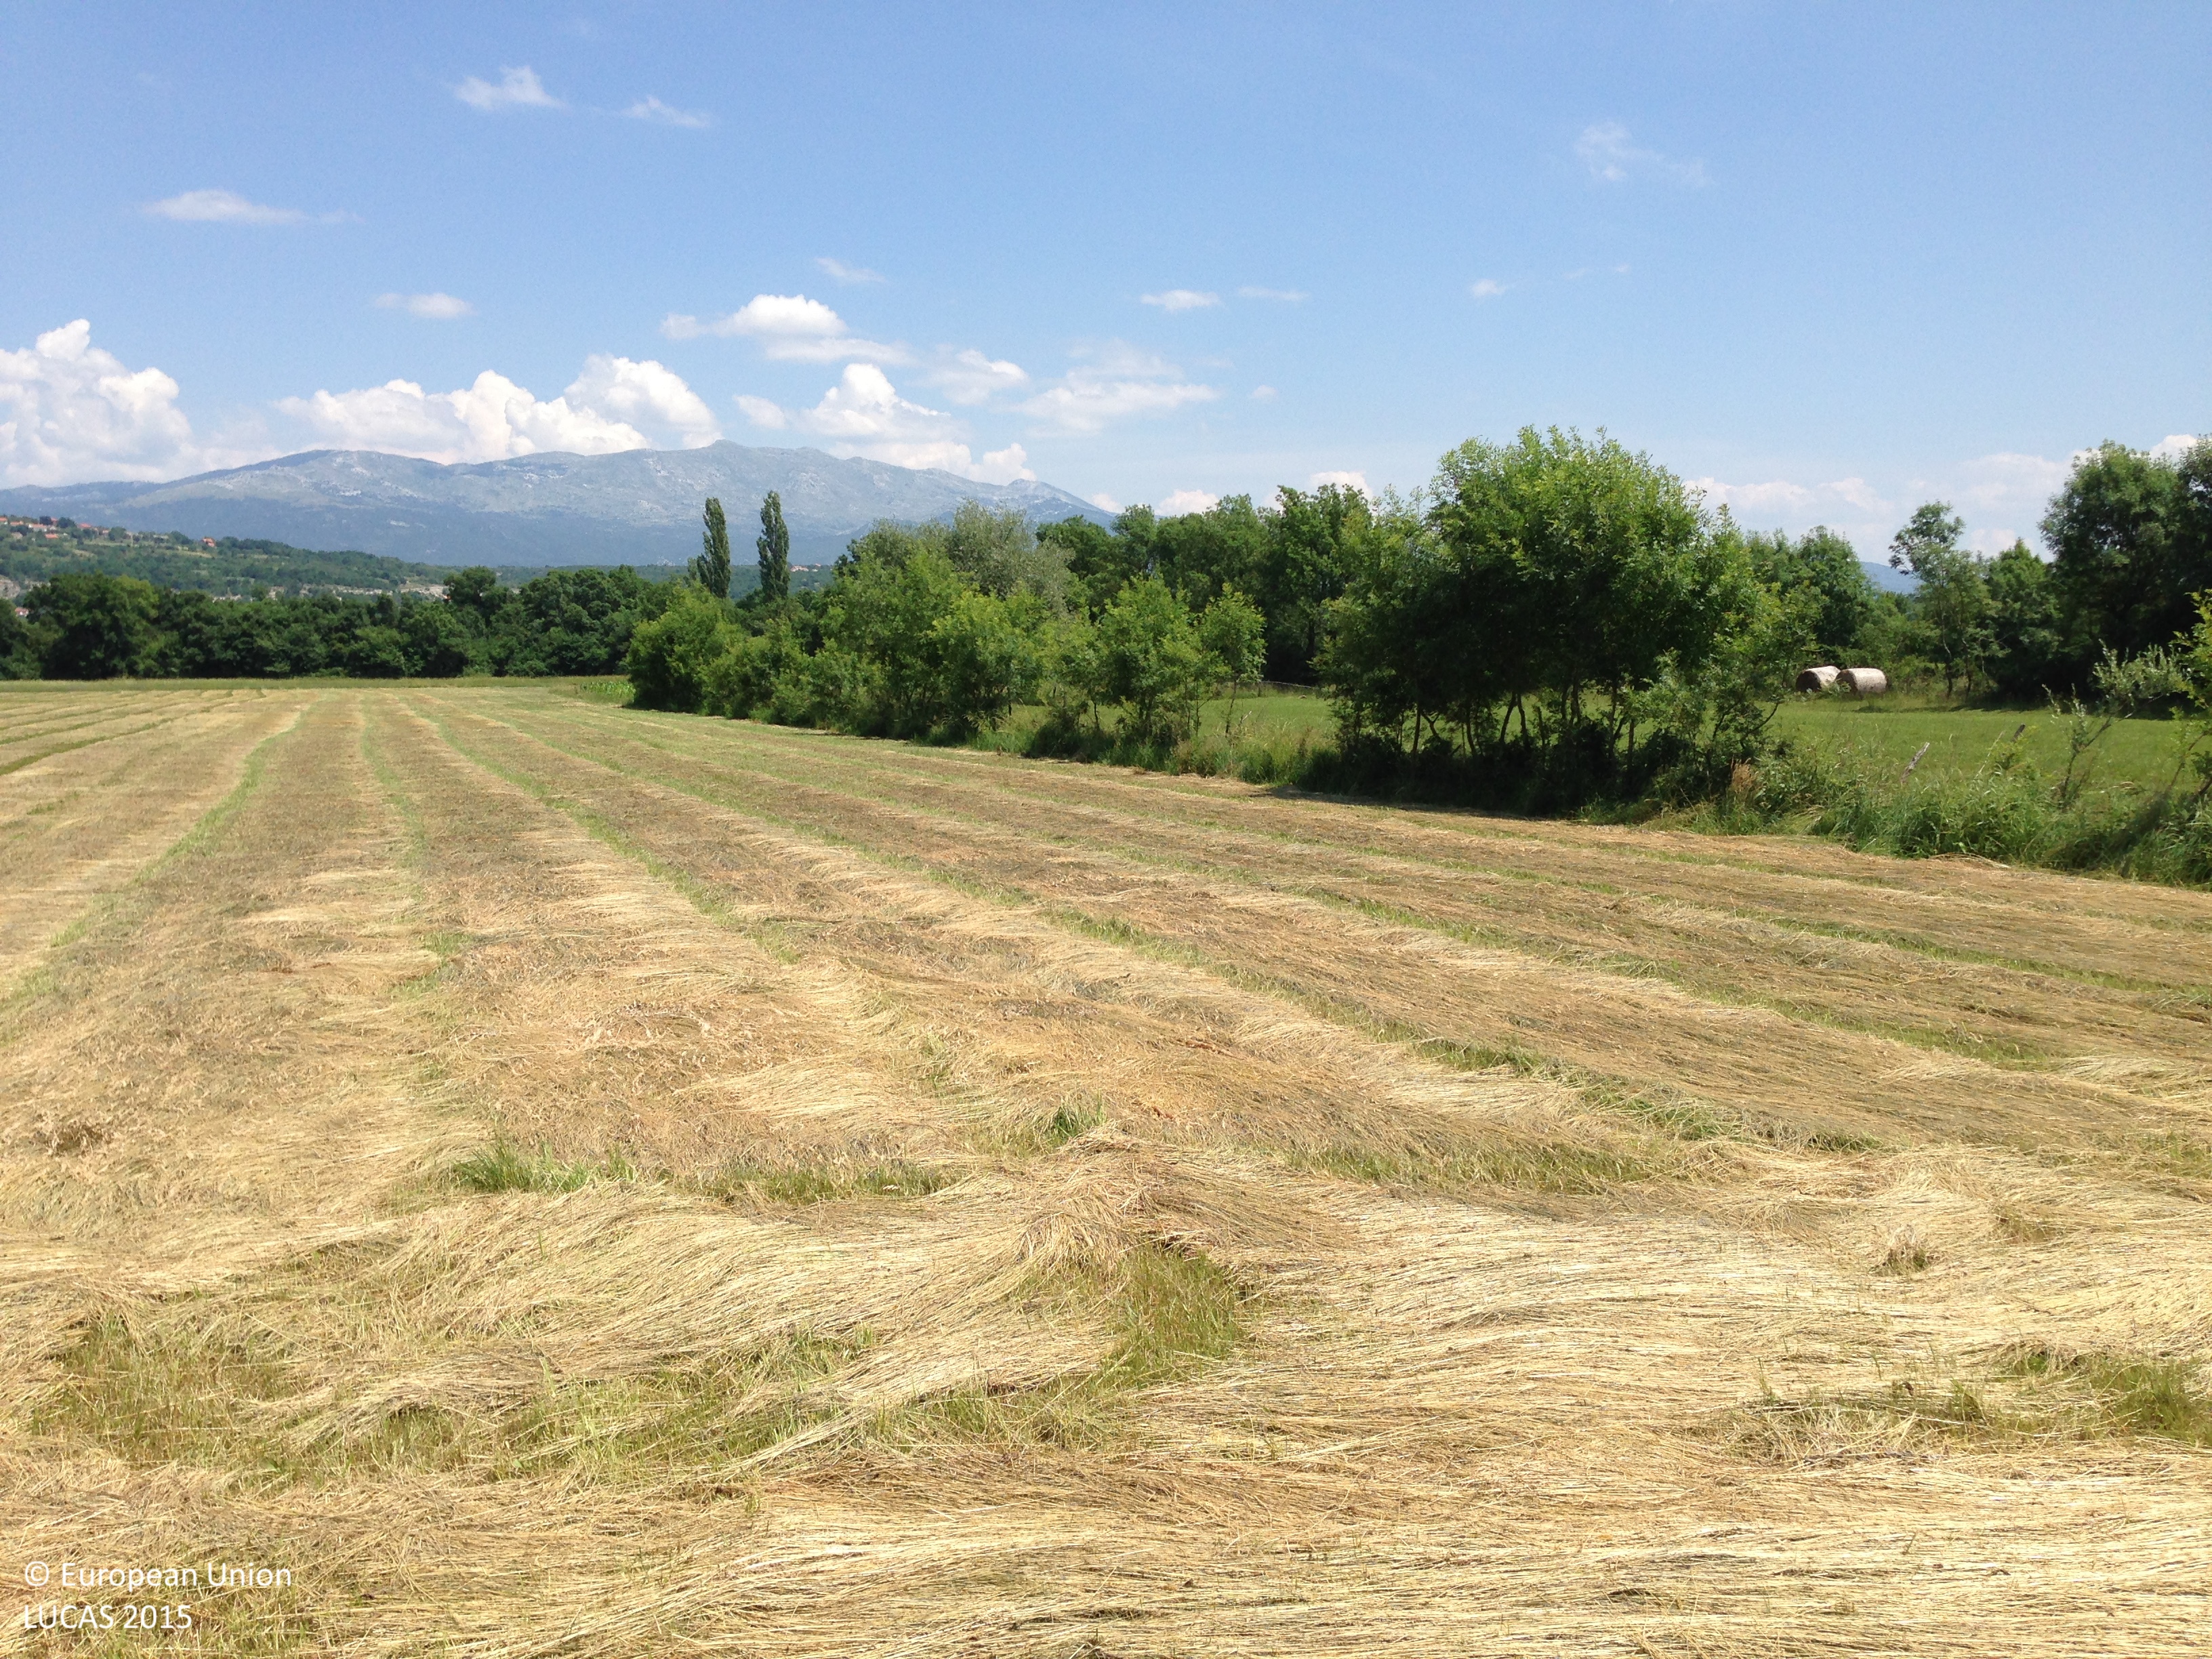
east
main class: Grassland
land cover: Grassland without tree/shrub cover
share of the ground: > 75 %
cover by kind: herbaceous plants 100 %
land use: Agriculture (excluding fallow land and kitchen gardens)
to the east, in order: Grassland without tree/shrub cover; Fences; Olive groves; Fences; Broadleaved woodland; Grassland without tree/shrub cover; Maize; Grassland without tree/shrub cover; Broadleaved woodland; Tracks; Broadleaved woodland
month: June
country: HR
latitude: 43.7384
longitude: 16.6597
